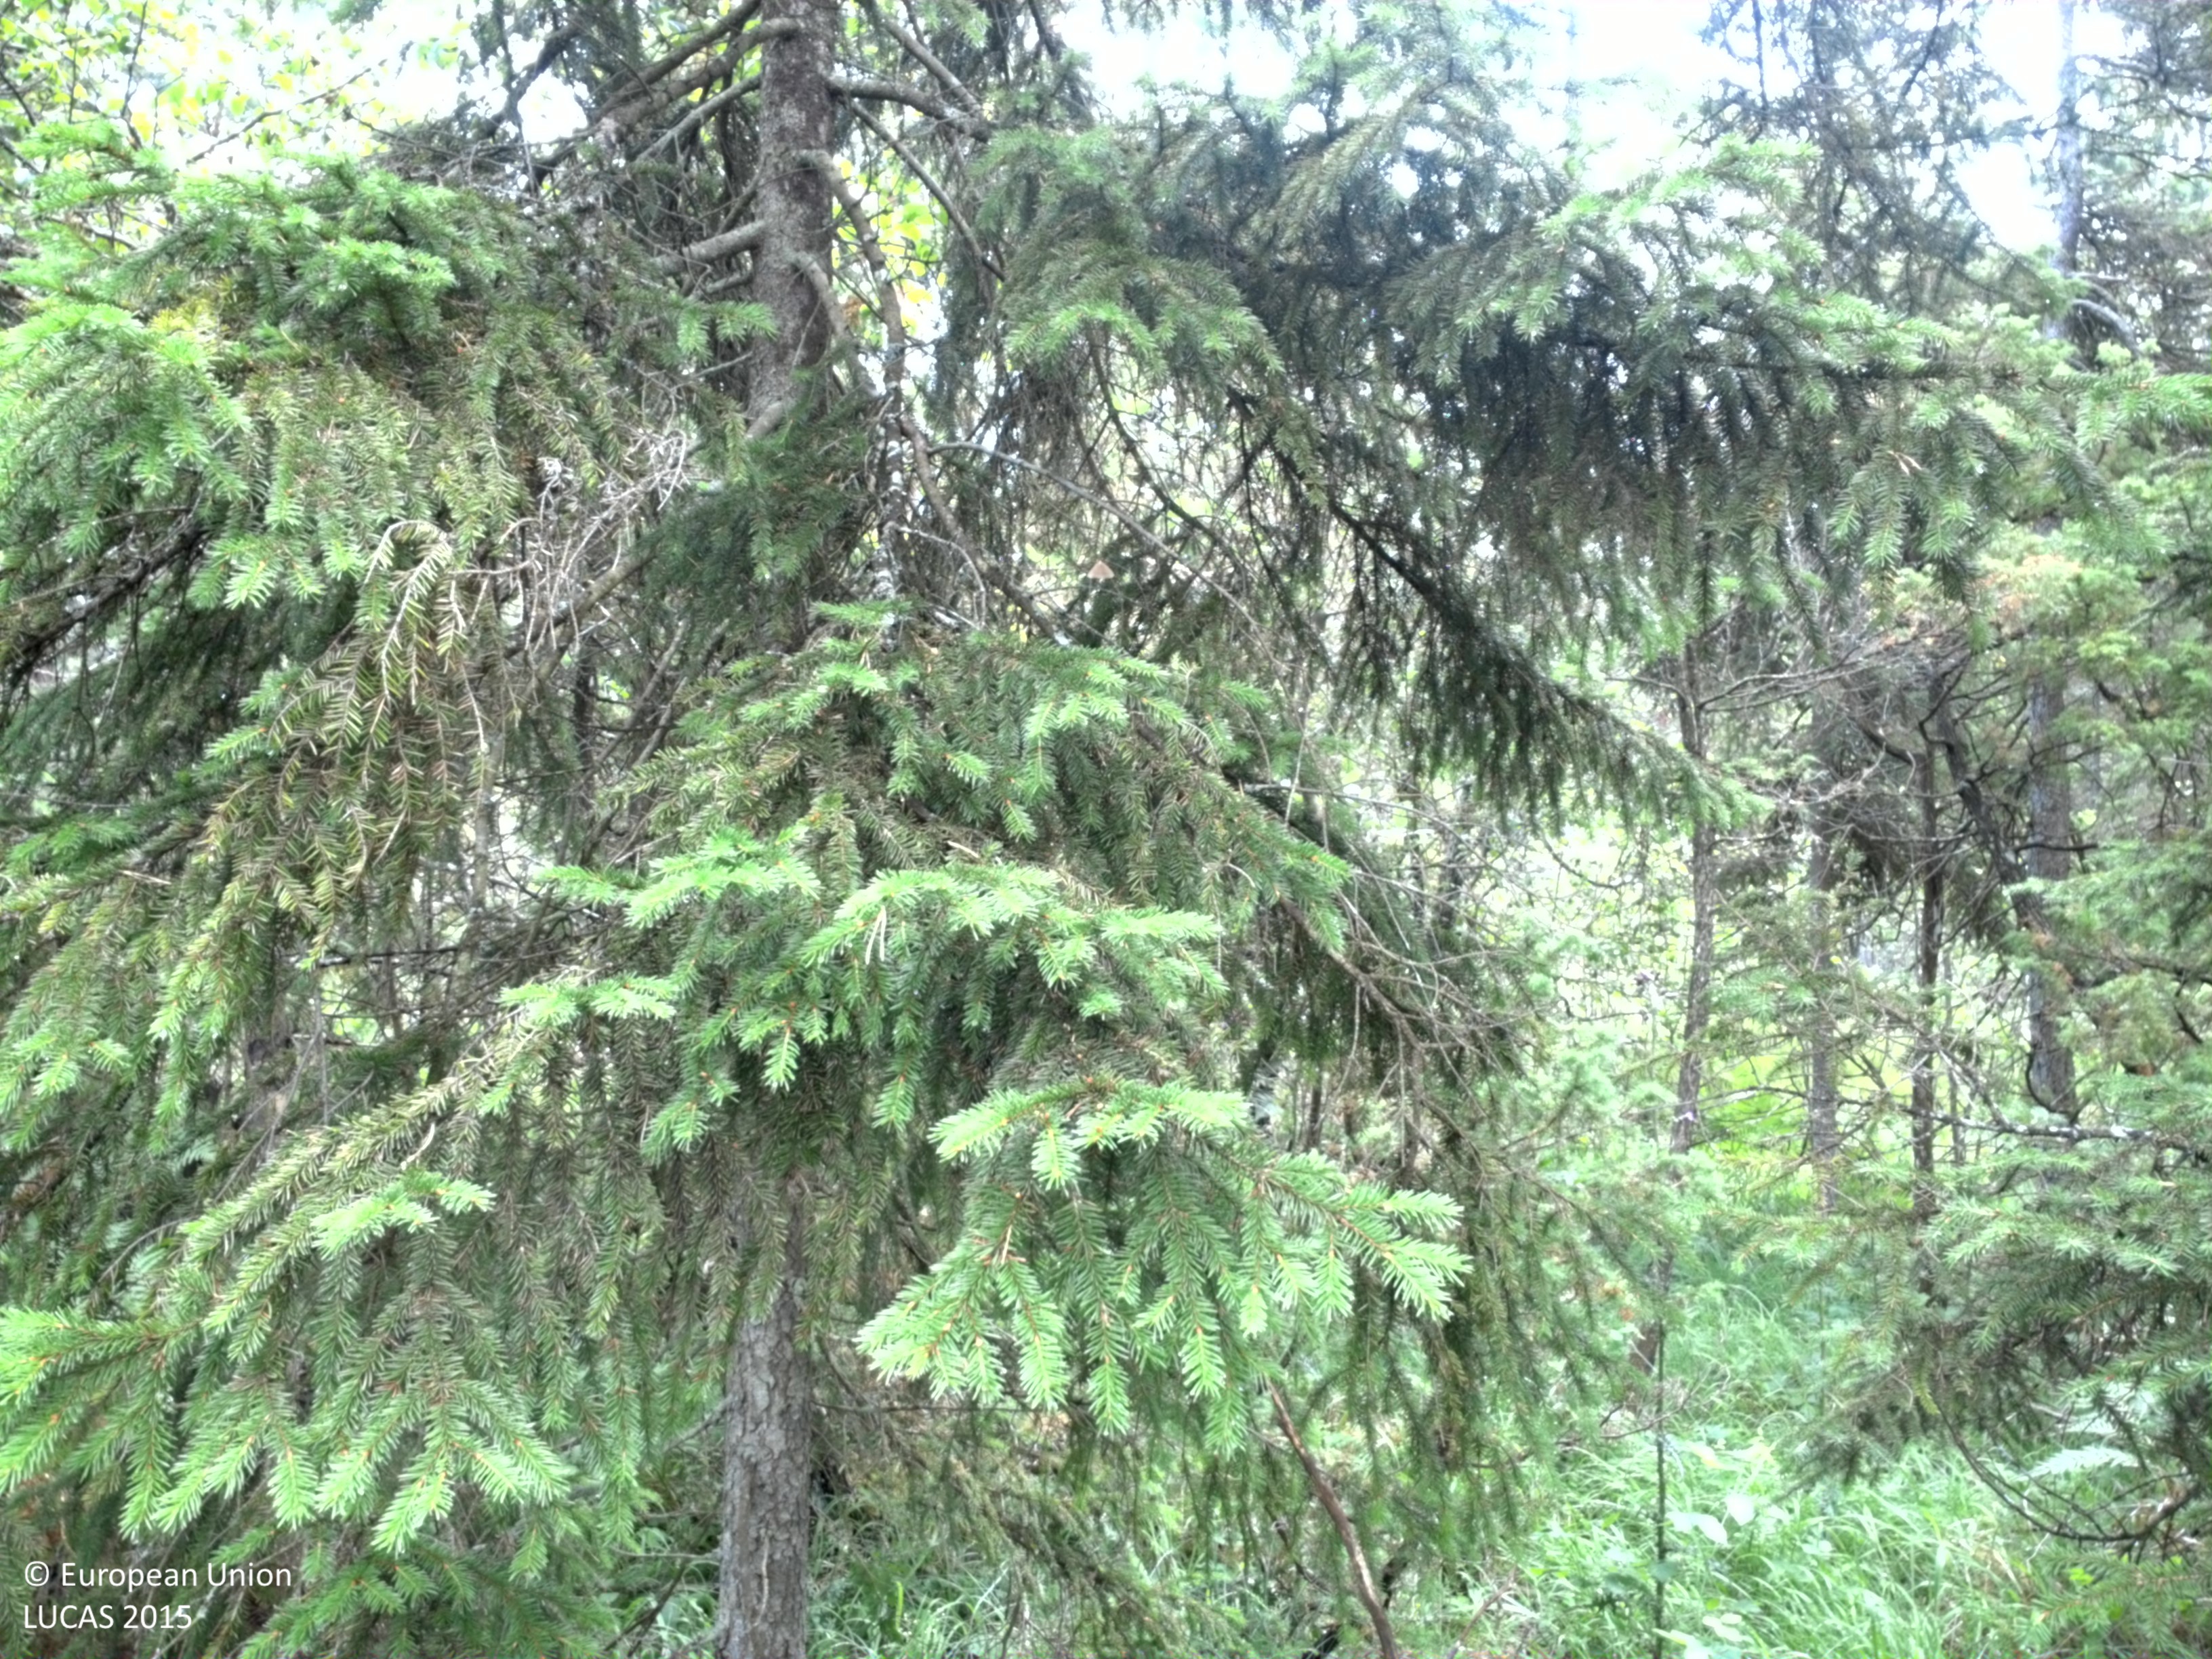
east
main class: Woodland
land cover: Other mixed woodland
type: hemiboreal forest and nemoral coniferous forest and mixed broadleaved-coniferous forest
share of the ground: 50 - 75 %
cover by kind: coniferous forest trees 50 %, broadleaved forest trees 20 %, shrubs 15 %, herbaceous plants 15 %
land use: Forestry
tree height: > 5 m
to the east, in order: Other mixed woodland
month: July
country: SE
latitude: 57.4088
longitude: 18.7497
